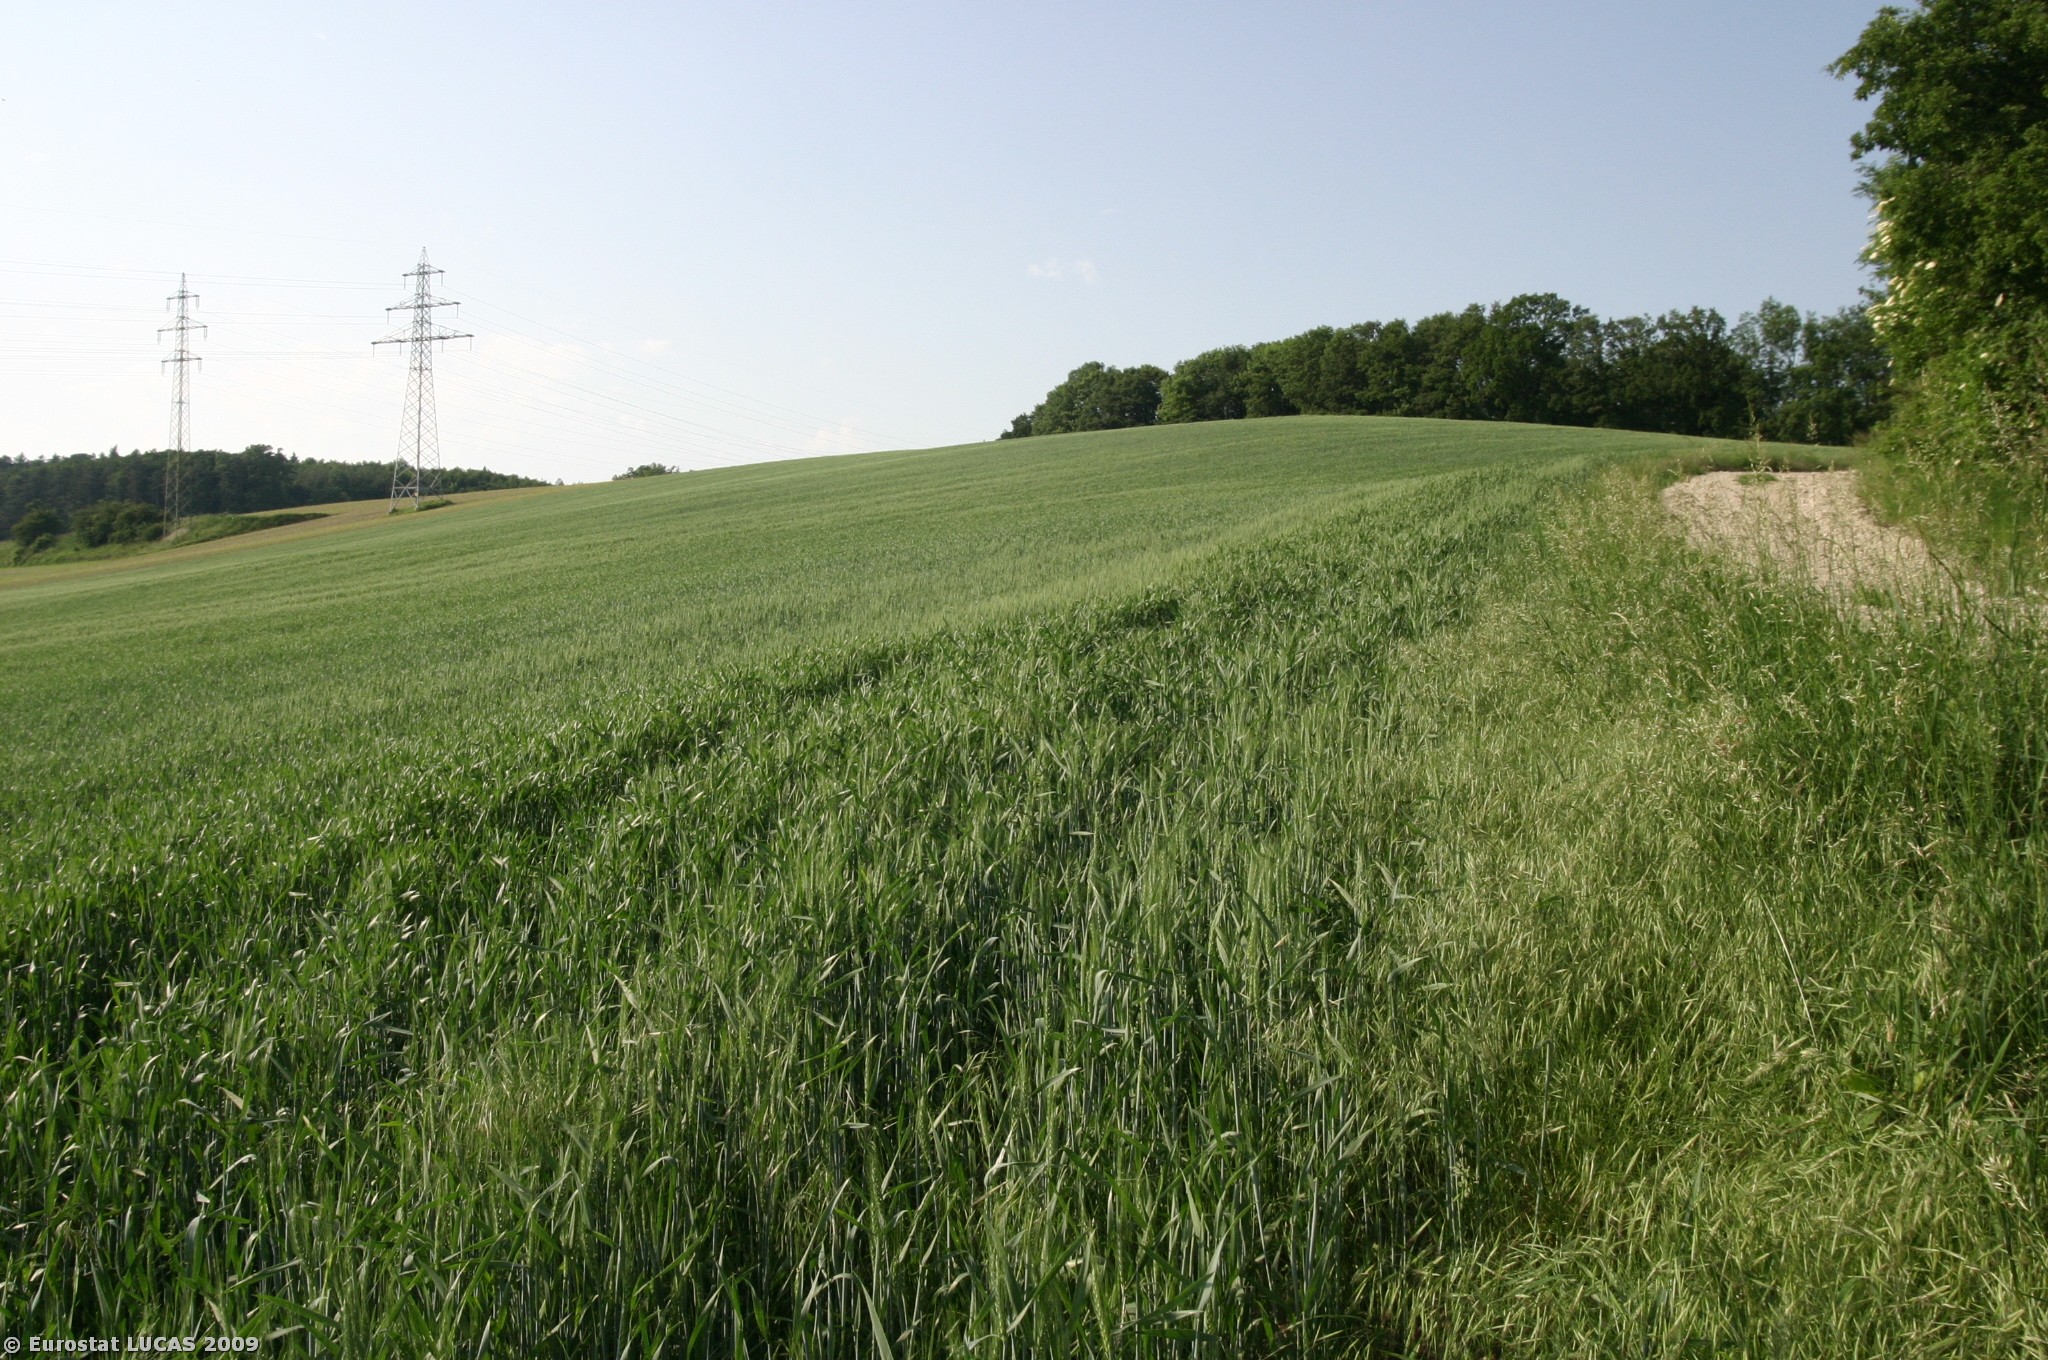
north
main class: Cropland
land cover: Triticale
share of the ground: > 75 %
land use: Agriculture (excluding fallow land and kitchen gardens)
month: May
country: AT
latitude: 48.2408
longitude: 15.9958
